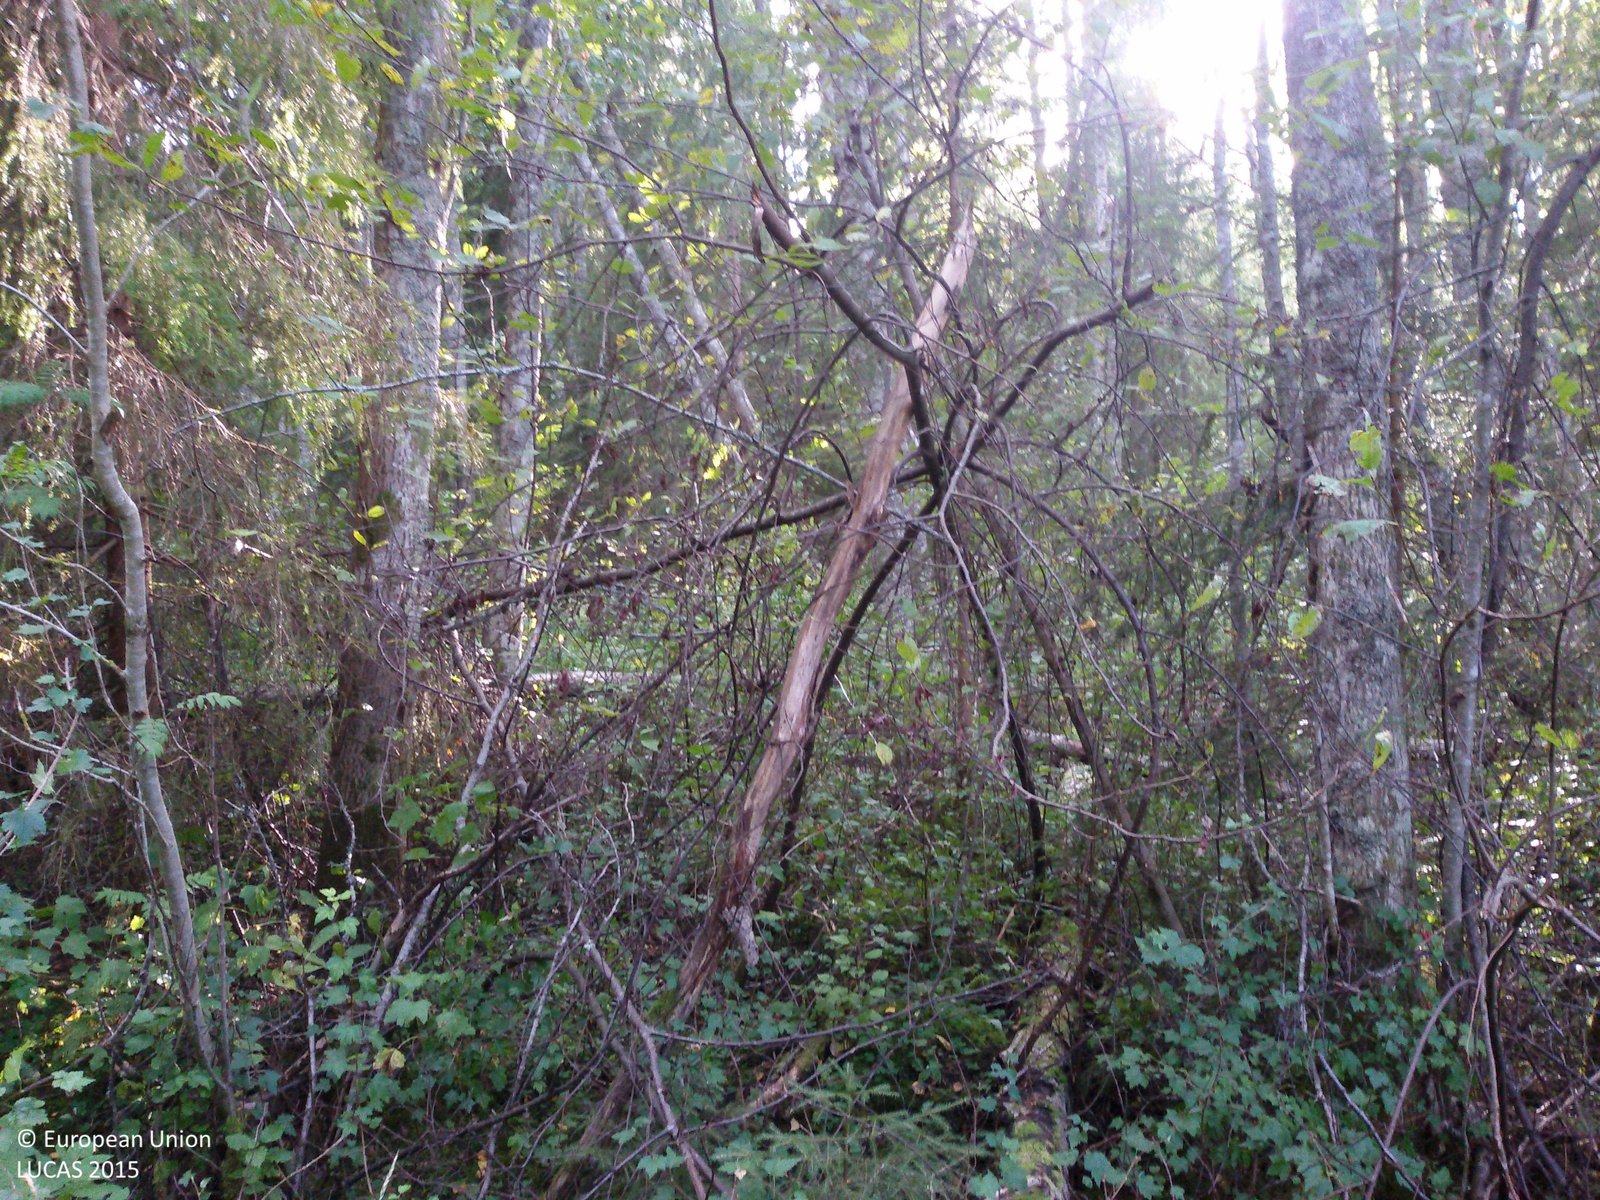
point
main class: Woodland
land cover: Spruce dominated mixed woodland
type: boreal forest
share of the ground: > 75 %
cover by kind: coniferous forest trees 30 %, broadleaved forest trees 30 %, herbaceous plants 25 %, shrubs 10 %, lichens and mosses 5 %
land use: Forestry
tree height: > 5 m
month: September
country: SE
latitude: 60.8303
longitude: 15.0447
